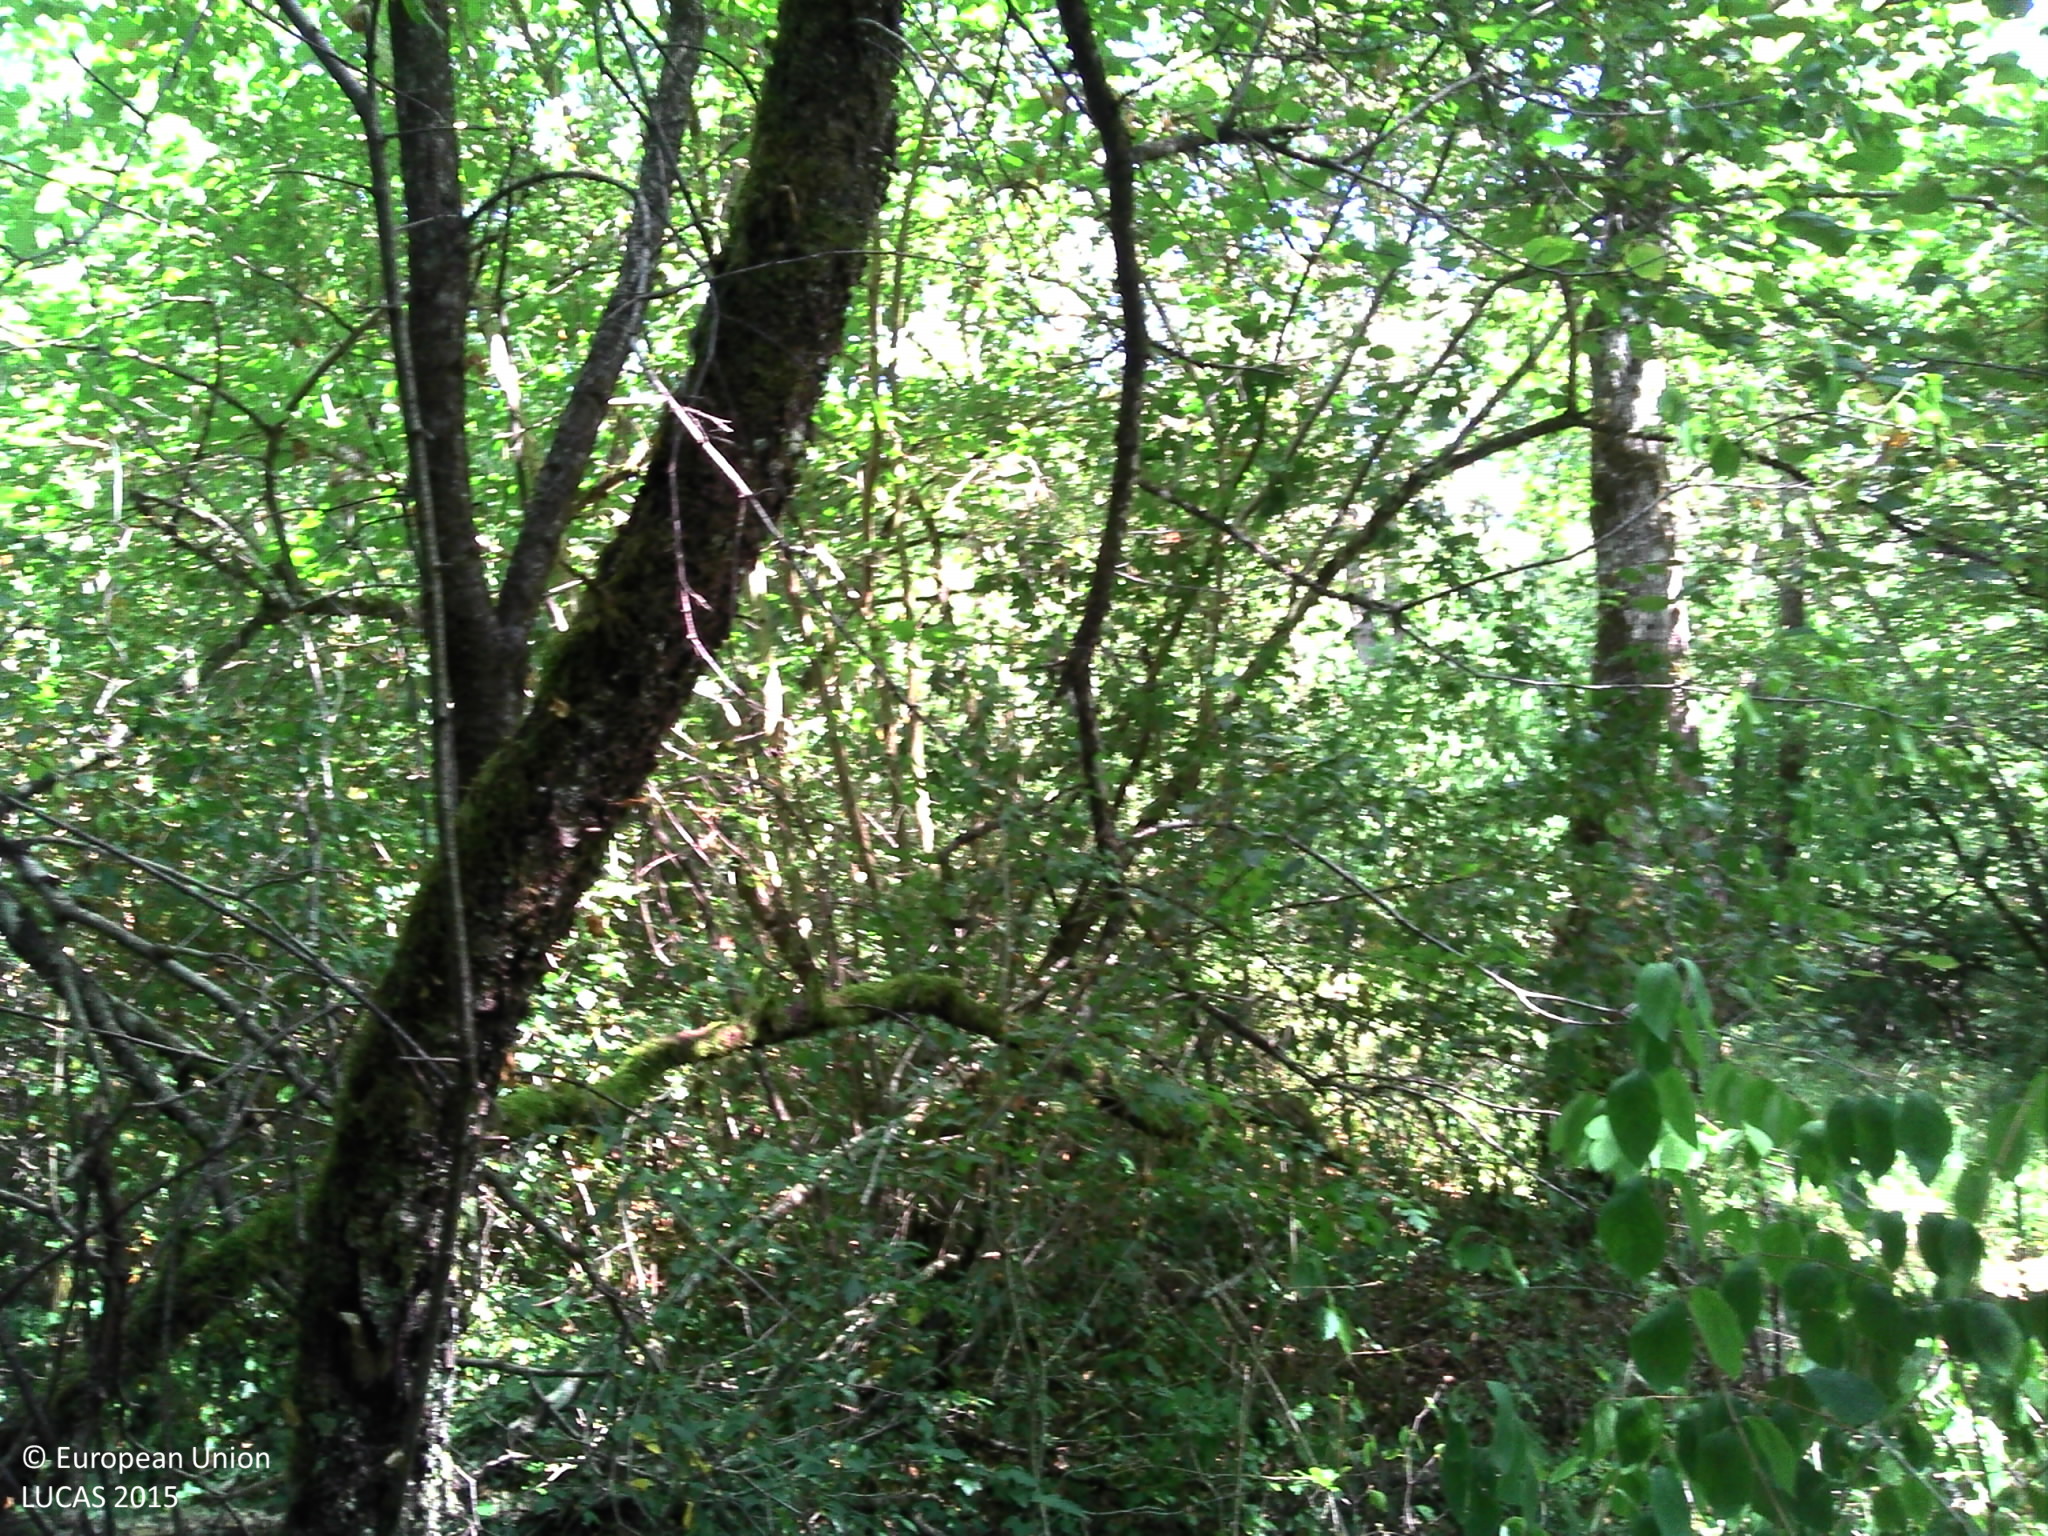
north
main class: Woodland
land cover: Broadleaved woodland
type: acidophilous oak and oak-birch forest
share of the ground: > 75 %
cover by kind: broadleaved forest trees 80 %, herbaceous plants 10 %, lichens and mosses 10 %
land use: Forestry
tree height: > 5 m
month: July
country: FR
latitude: 47.8835
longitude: 5.1722
